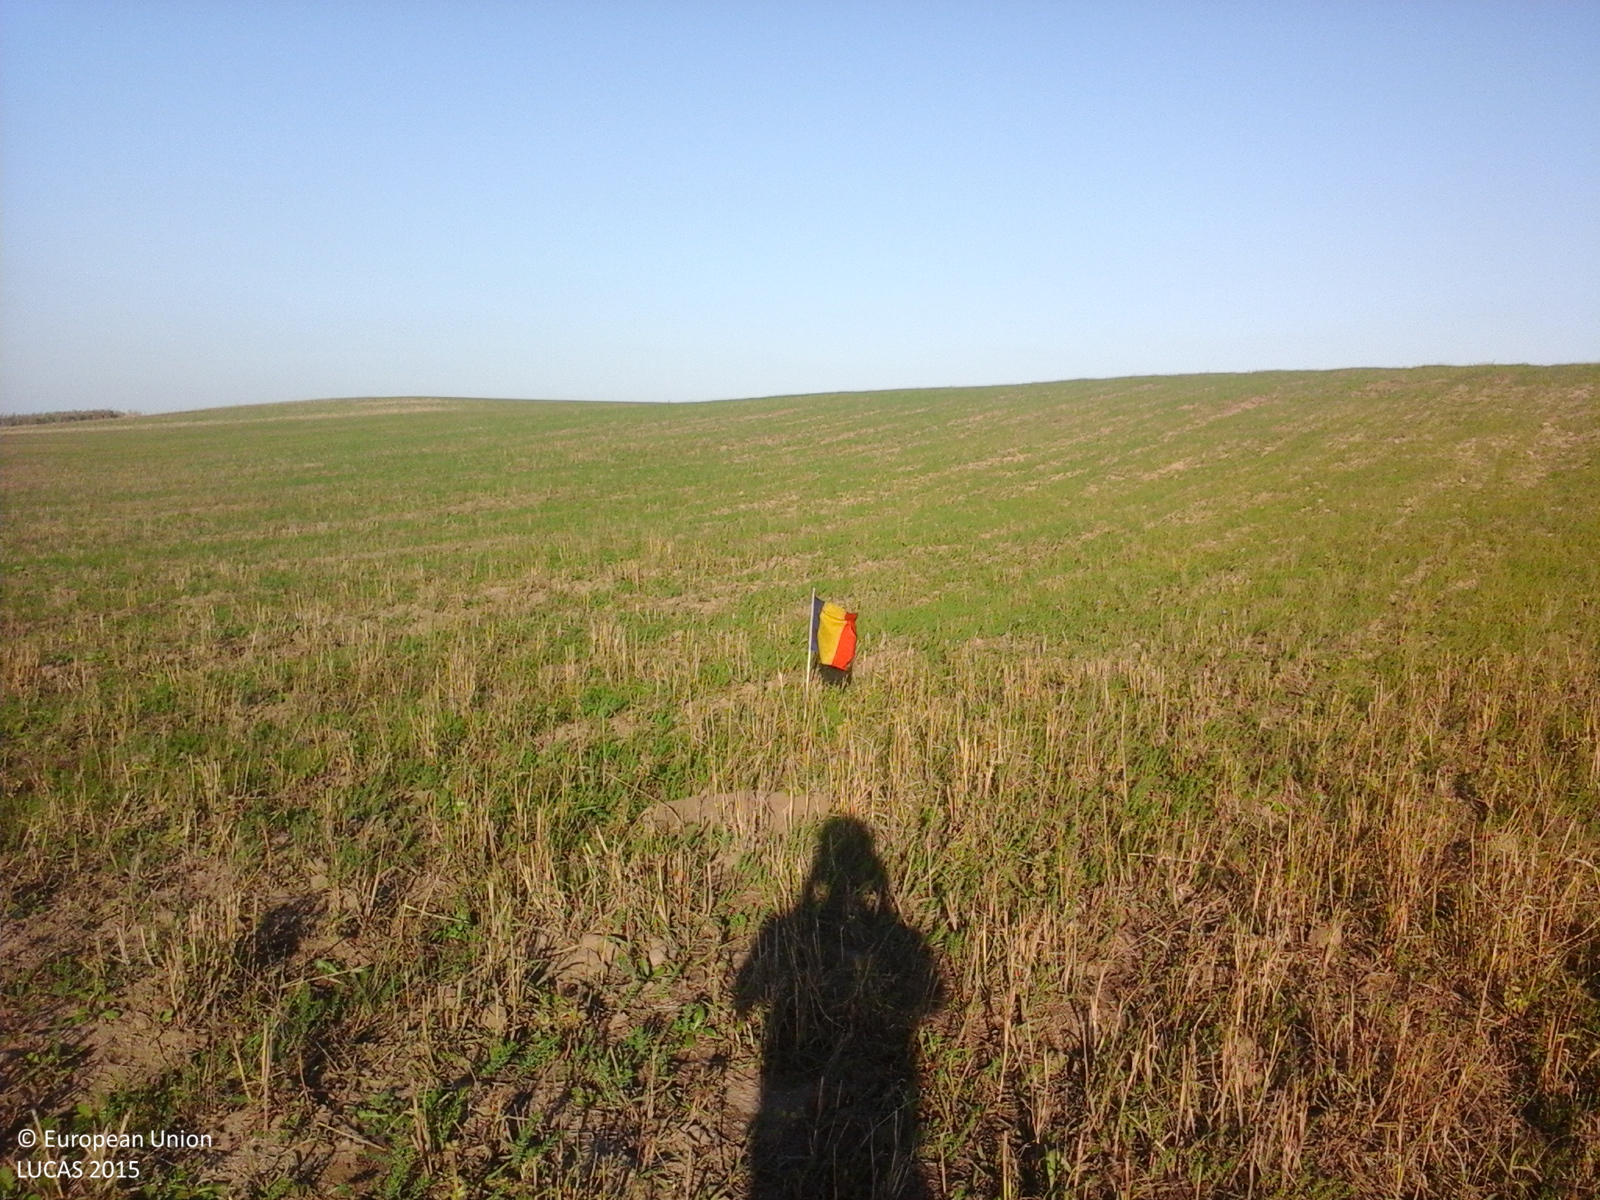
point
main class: Cropland
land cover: Temporary grasslands
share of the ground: > 75 %
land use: Agriculture (excluding fallow land and kitchen gardens)
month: October
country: RO
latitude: 45.3753
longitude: 27.3746
